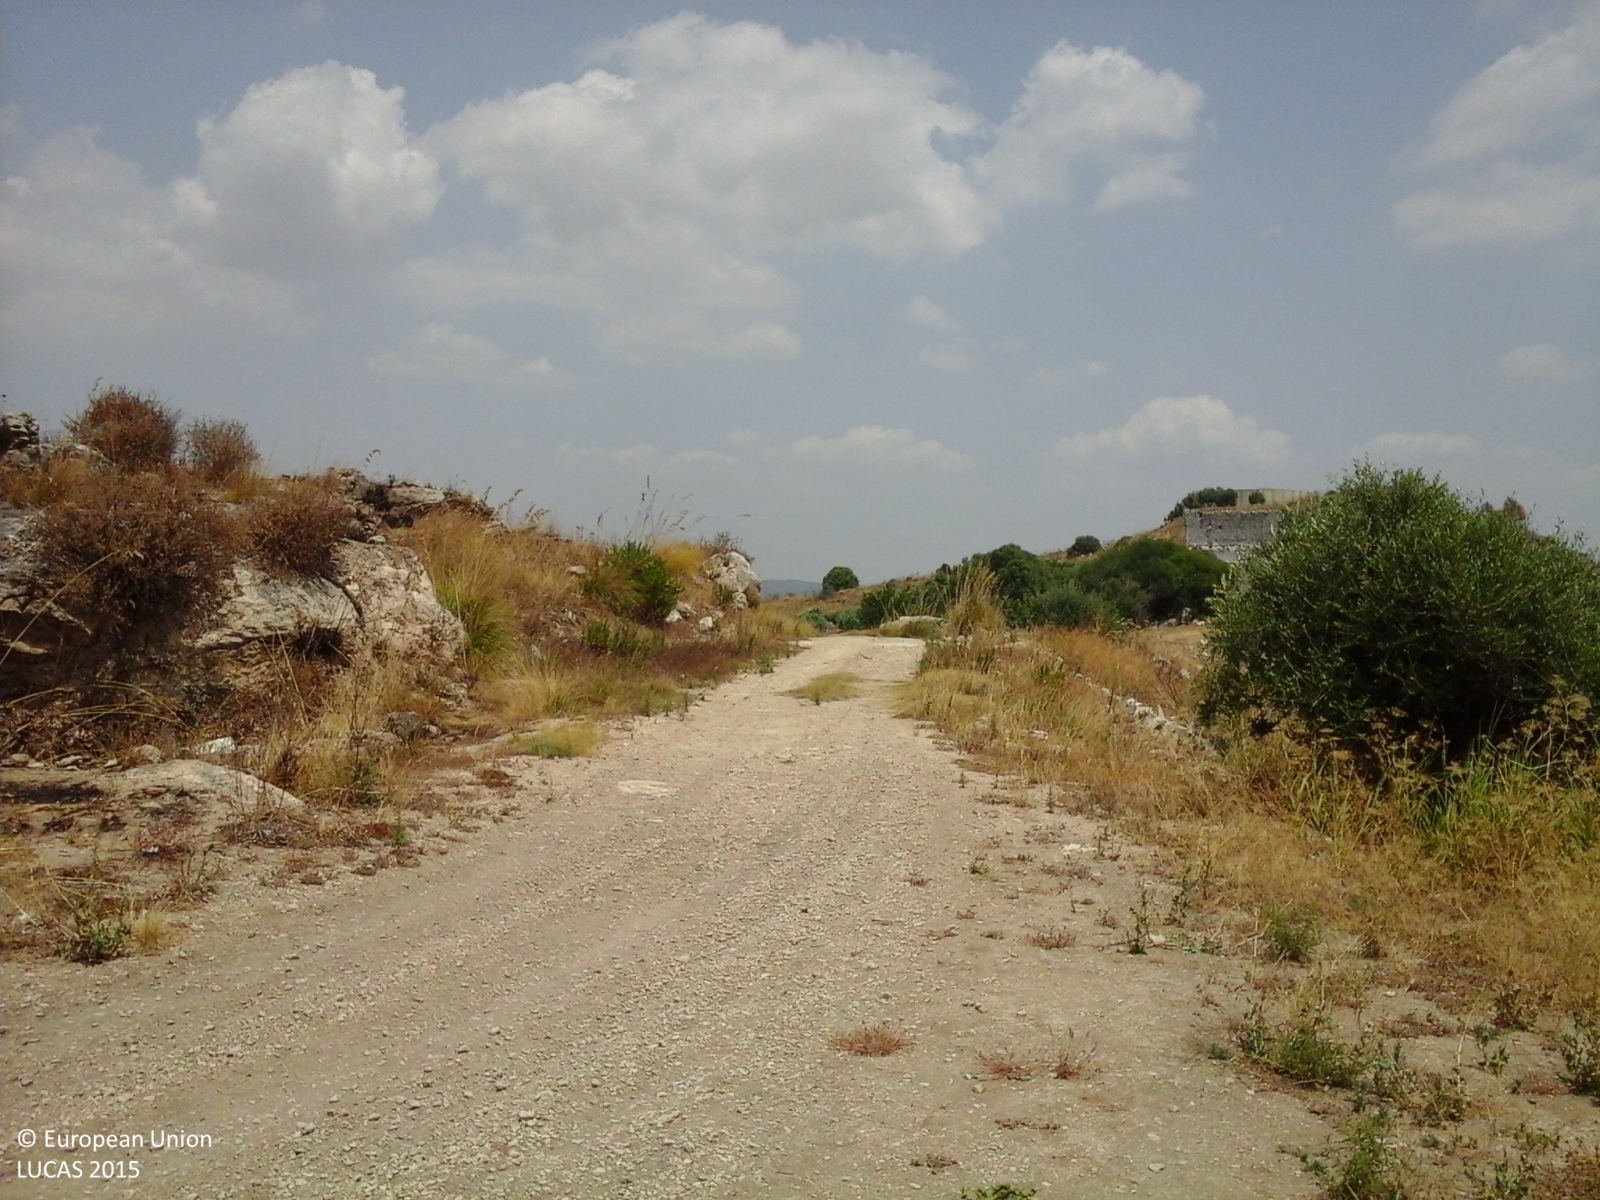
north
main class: Grassland
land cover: Grassland without tree/shrub cover
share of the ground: > 75 %
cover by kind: herbaceous plants 75 %, consolidated bare surface 25 %
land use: Semi-natural and natural areas not in use
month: July
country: IT
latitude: 37.3162
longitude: 14.0424
